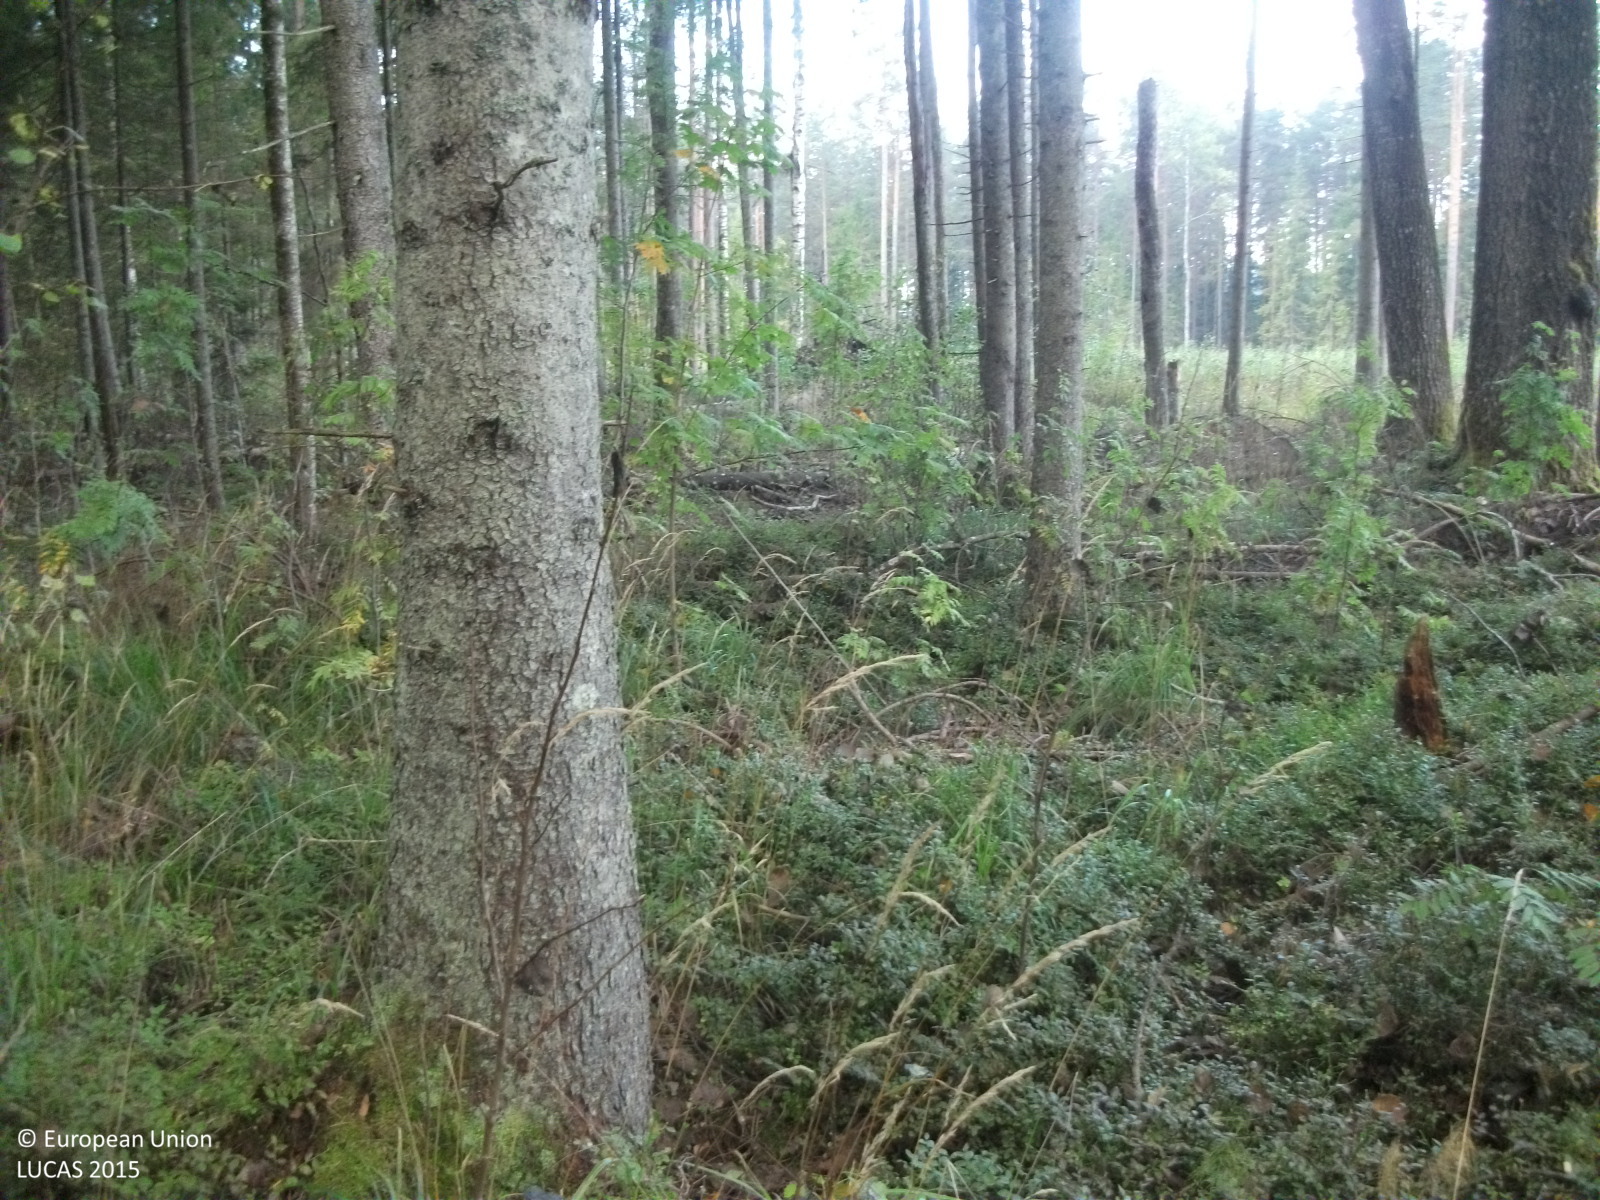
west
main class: Woodland
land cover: Spruce dominated coniferous woodland
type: hemiboreal forest and nemoral coniferous forest and mixed broadleaved-coniferous forest
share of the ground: > 75 %
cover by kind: coniferous forest trees 80 %, broadleaved forest trees 10 %, shrubs 5 %, herbaceous plants 5 %
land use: Forestry
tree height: > 5 m
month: September
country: LV
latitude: 57.9018
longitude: 24.5156
